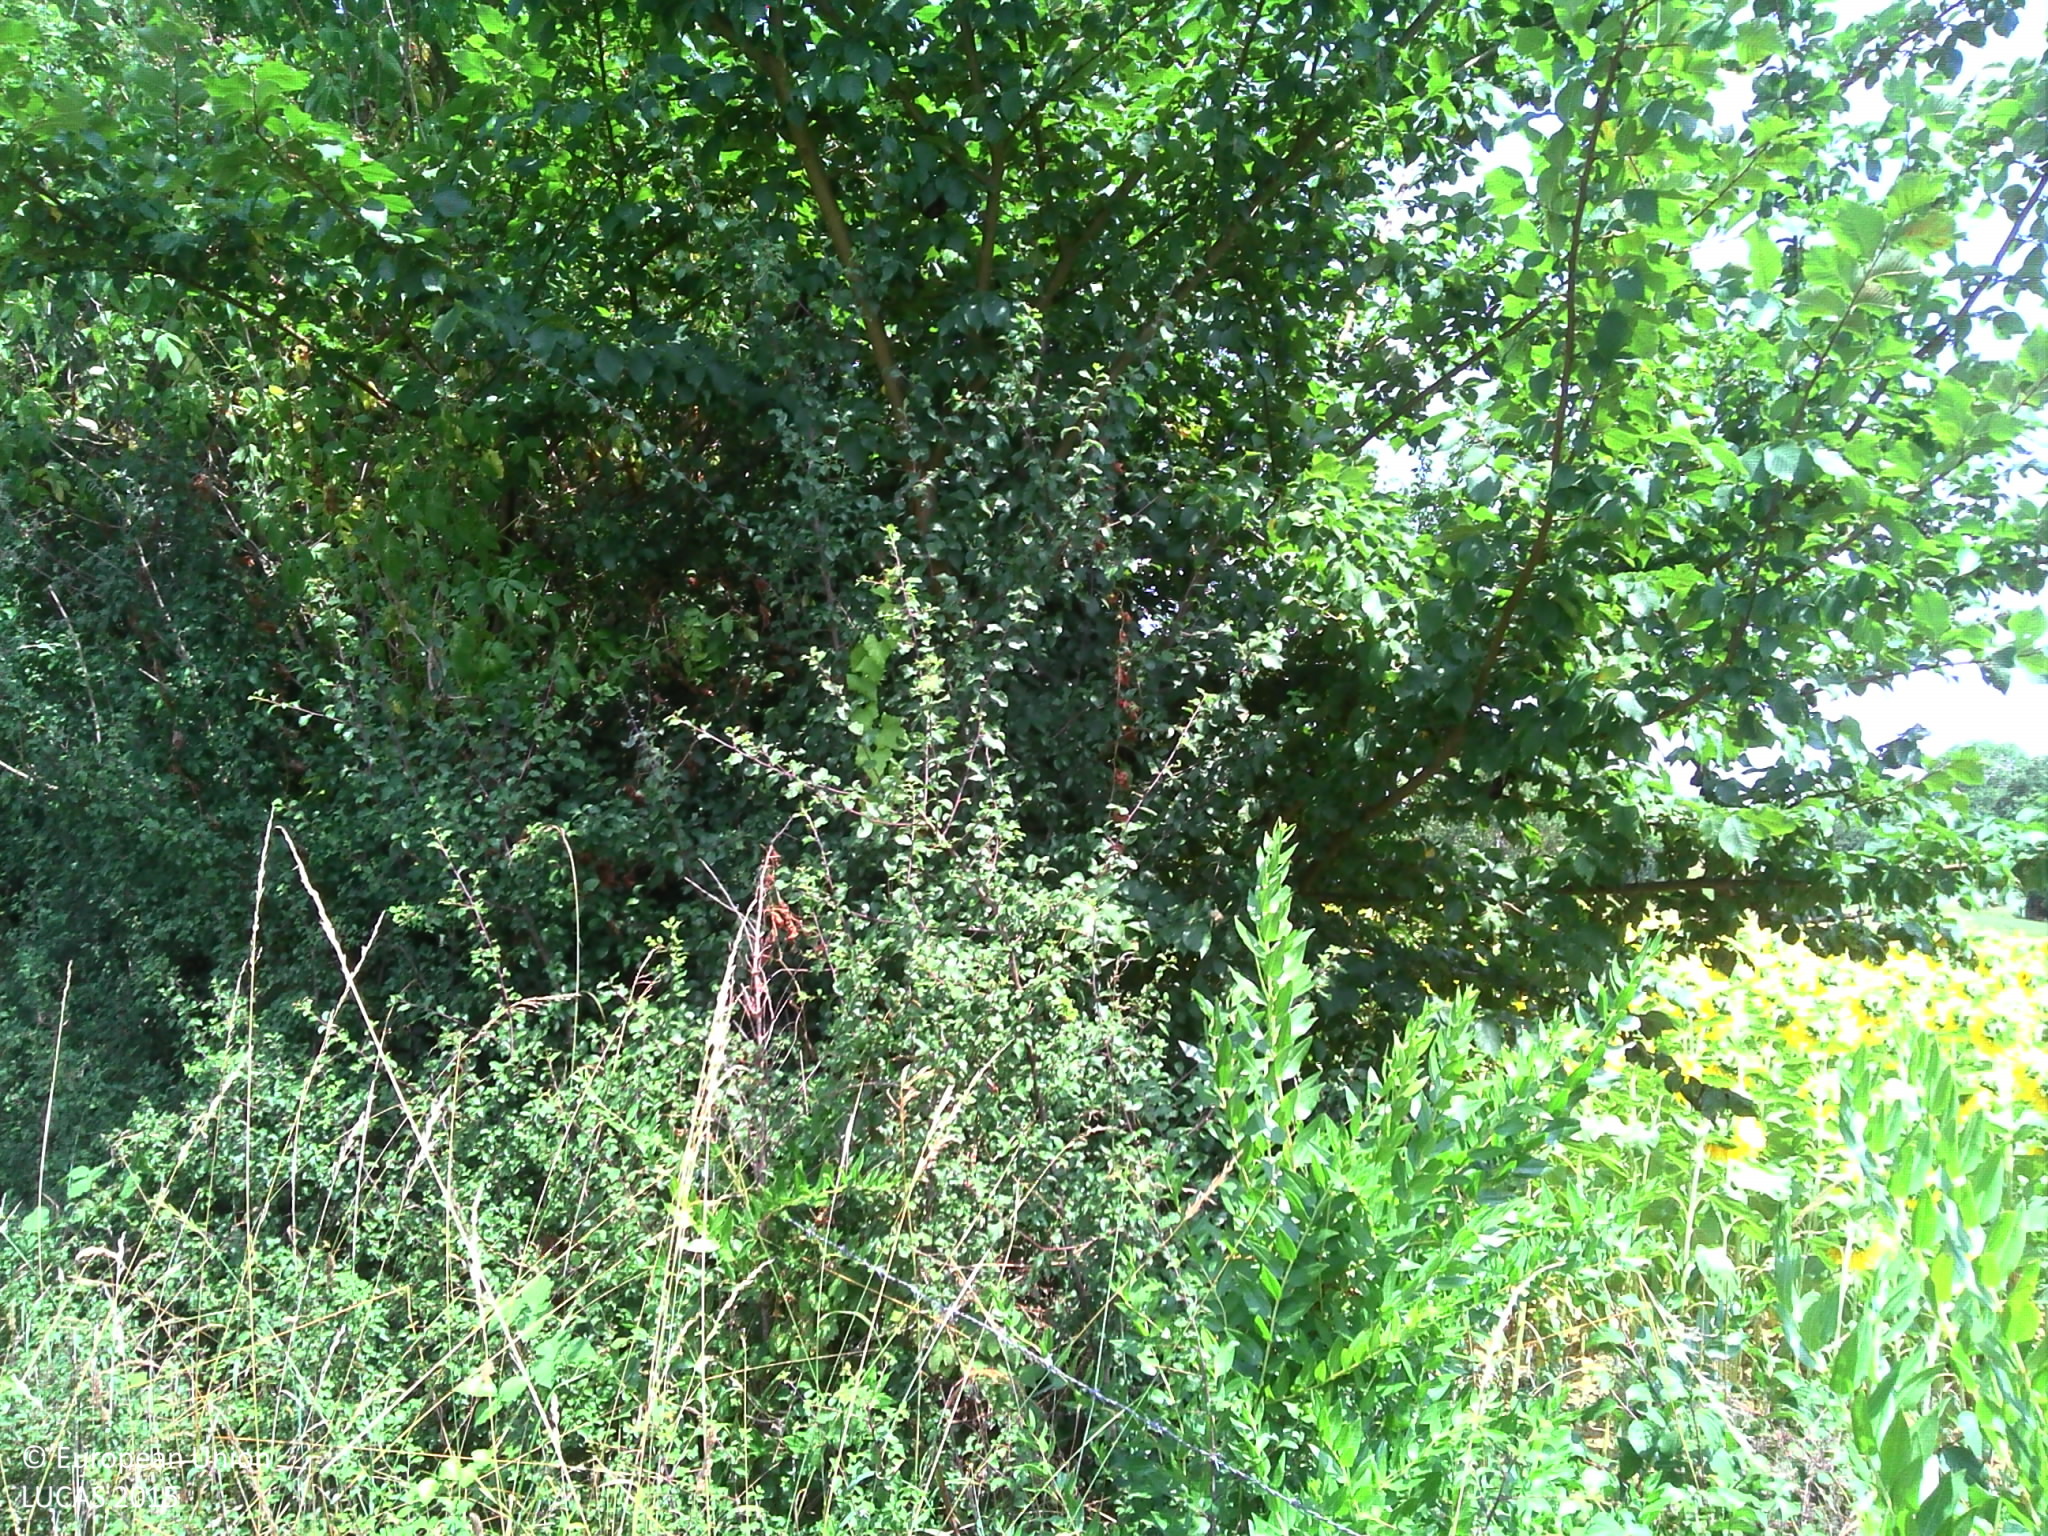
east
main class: Grassland
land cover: Grassland without tree/shrub cover
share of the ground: > 75 %
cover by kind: herbaceous plants 100 %
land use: Agriculture (excluding fallow land and kitchen gardens)
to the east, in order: Grassland without tree/shrub cover; Fences; Grass margins; Abandoned hedges; Sunflower; Broadleaved woodland; Electric lines; Broadleaved woodland; Grassland without tree/shrub cover; Abandoned hedges; Grass margins; Paved roads, cycling and walking lanes; Grass margins; Grassland without tree/shrub cover; Broadleaved woodland
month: July
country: FR
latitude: 43.0878
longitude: 1.4187
